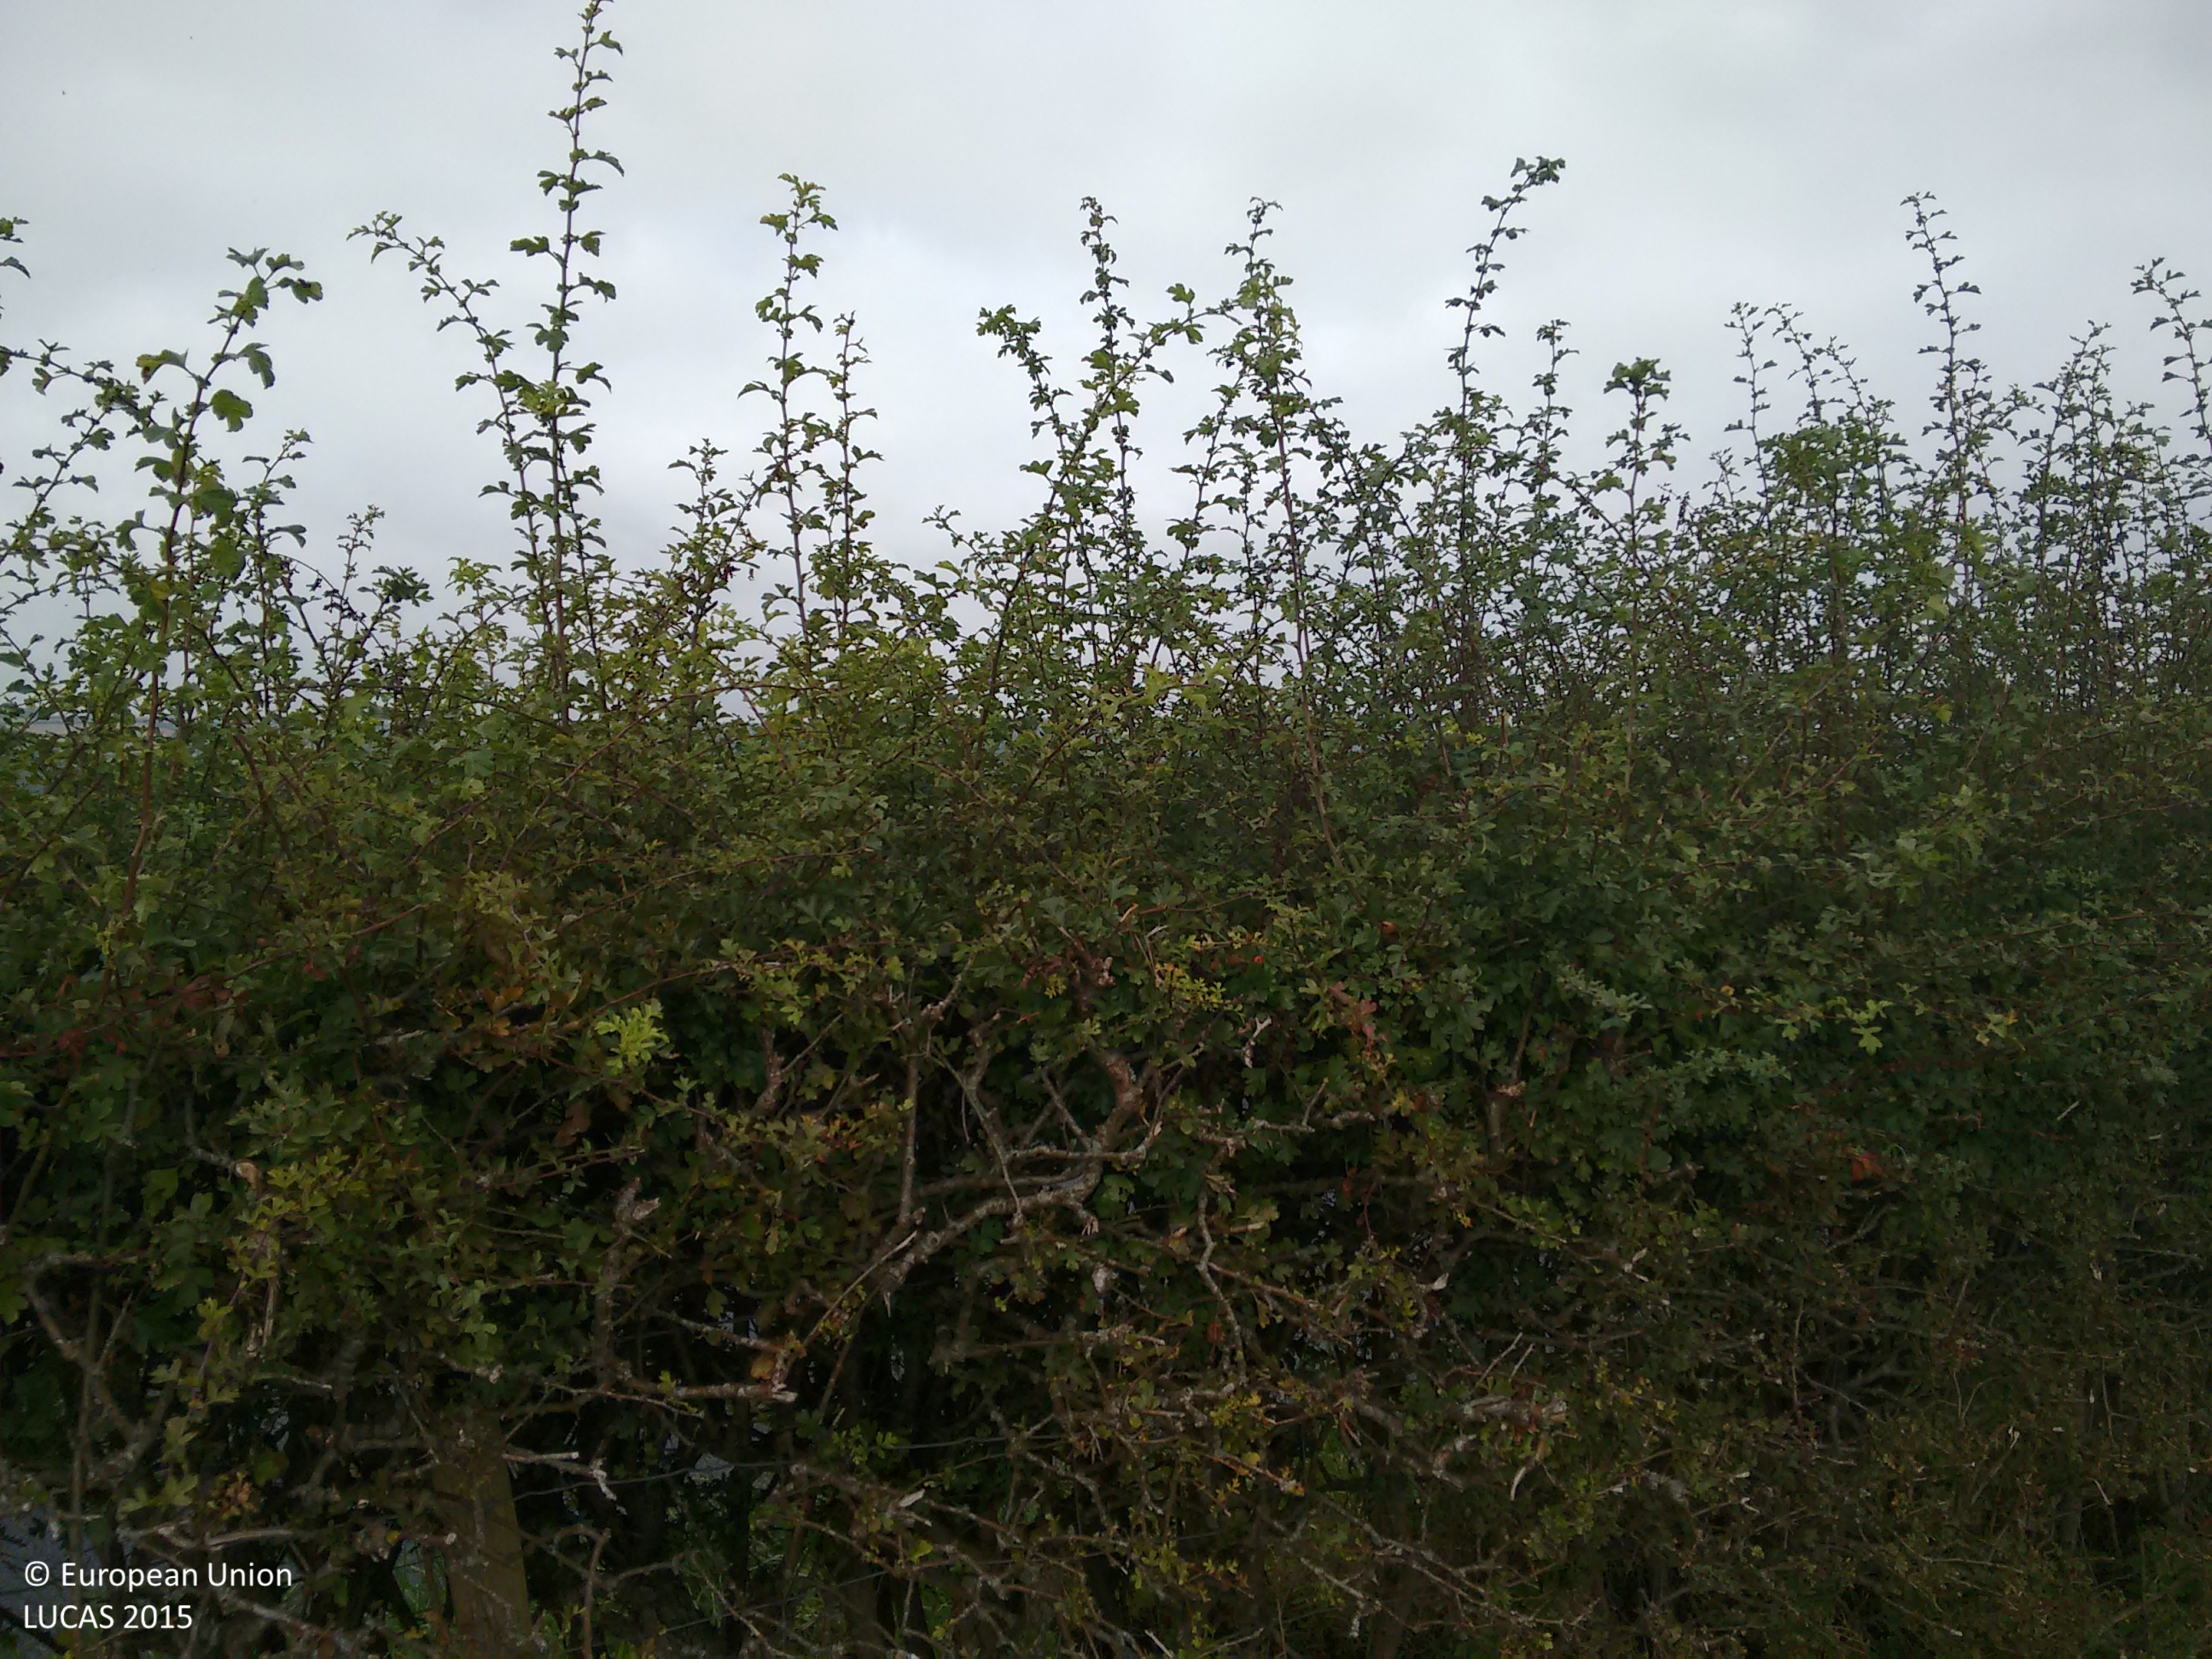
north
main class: Grassland
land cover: Grassland without tree/shrub cover
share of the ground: > 75 %
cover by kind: herbaceous plants 100 %
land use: Agriculture (excluding fallow land and kitchen gardens)
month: September
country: GB
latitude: 52.0598
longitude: -3.1611
